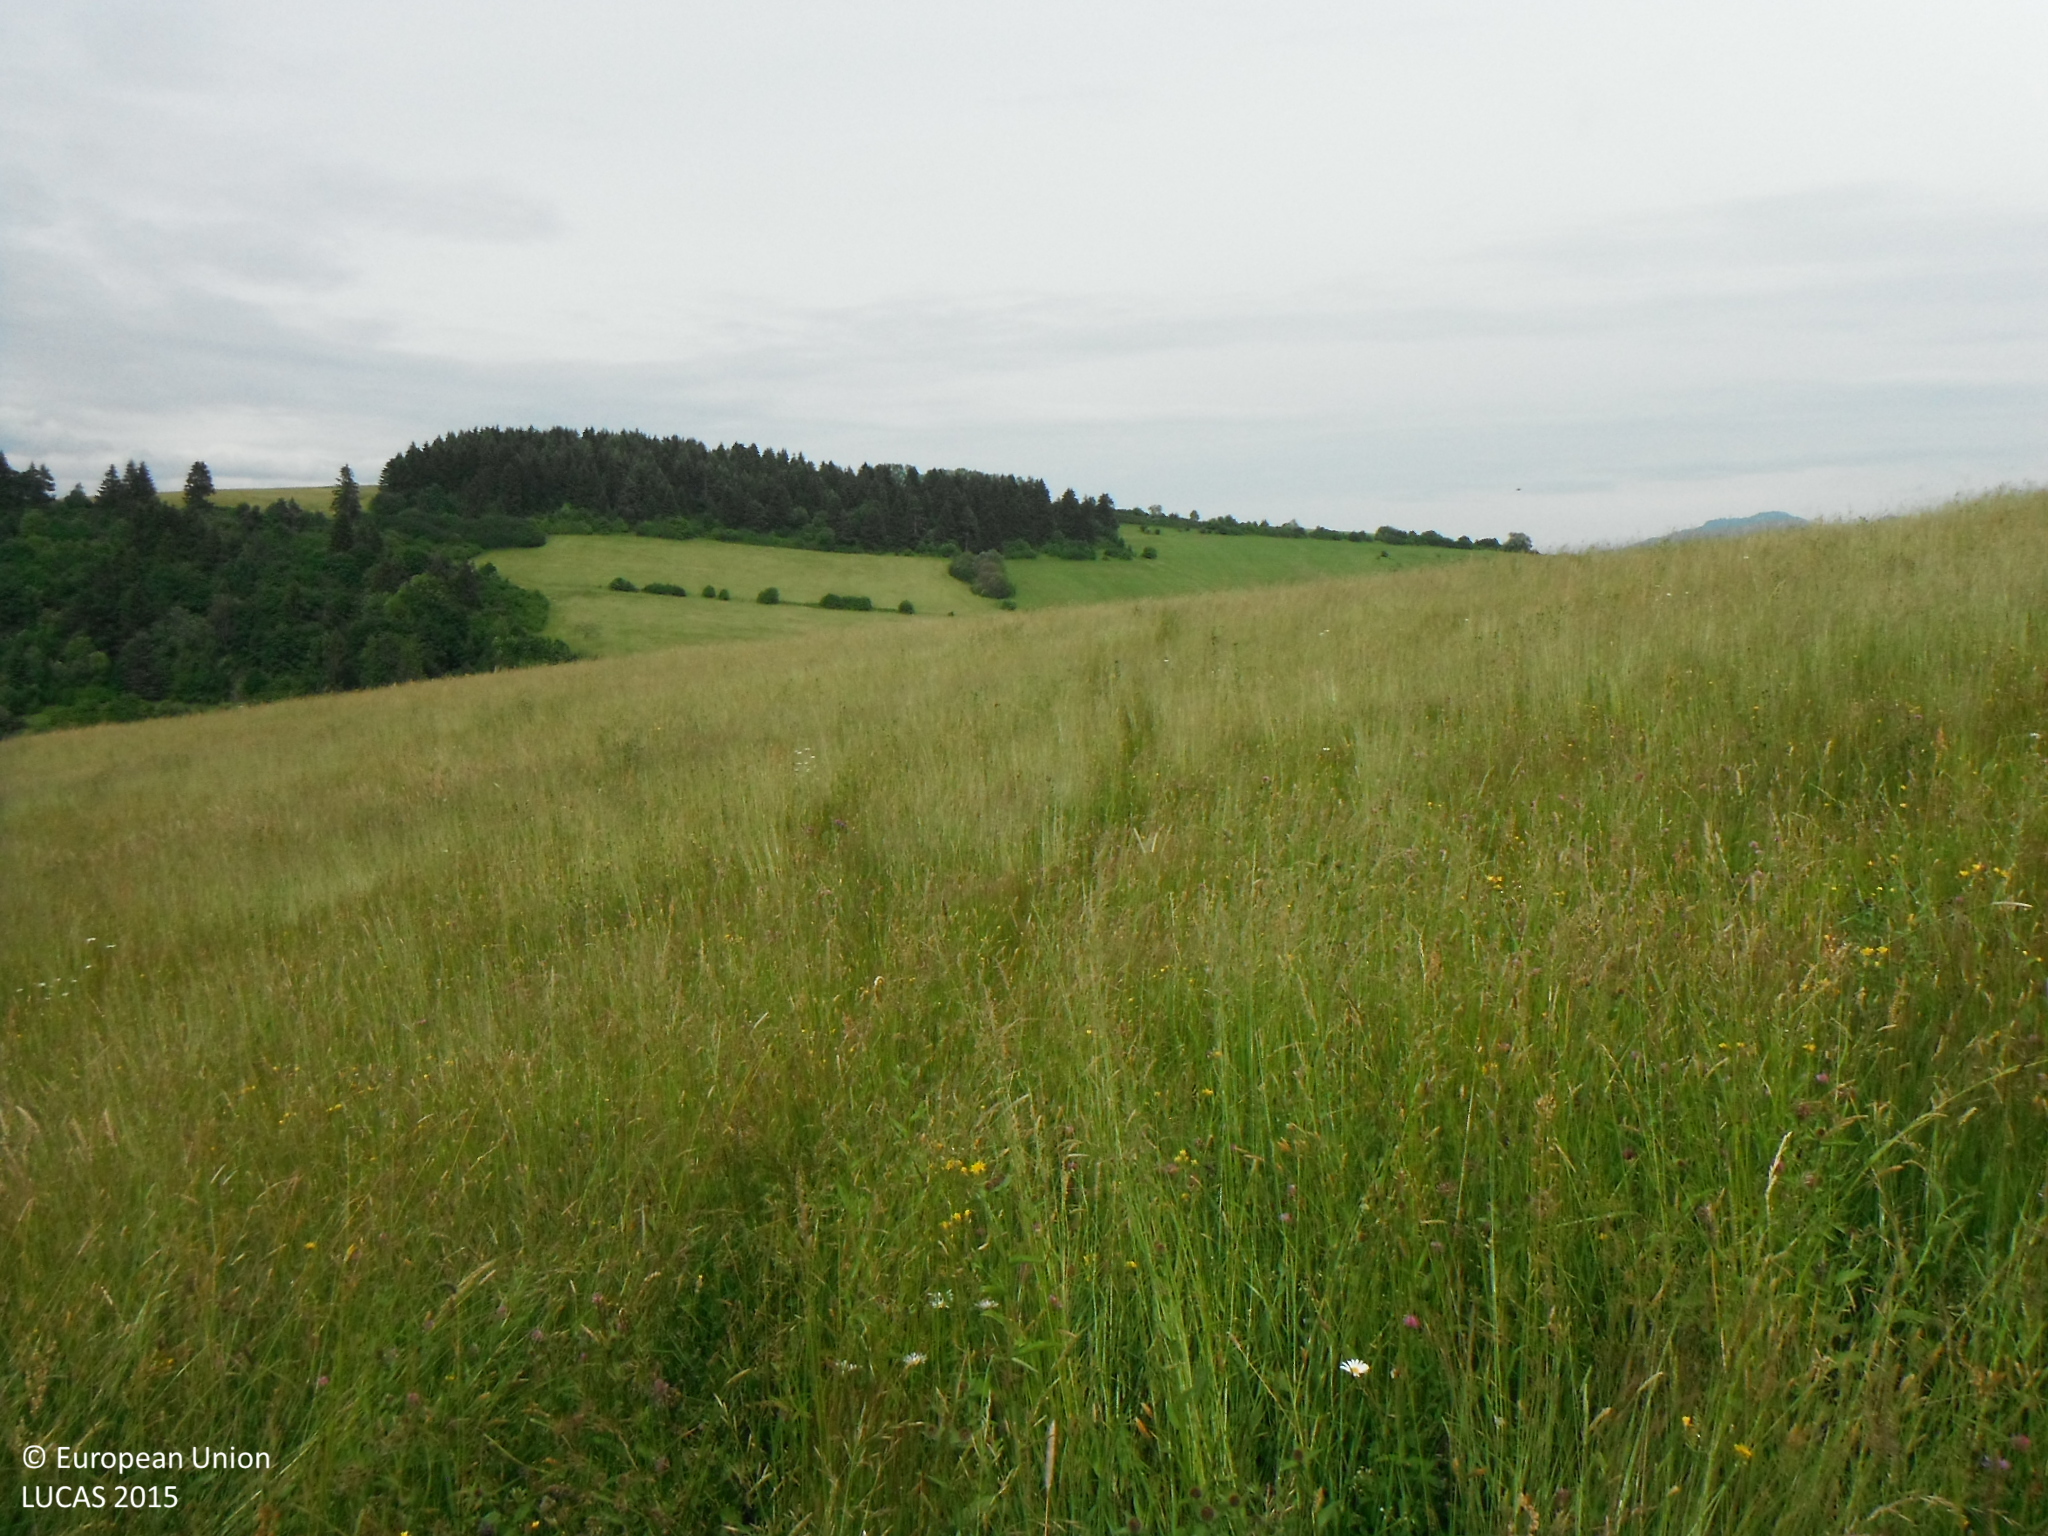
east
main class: Grassland
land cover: Grassland without tree/shrub cover
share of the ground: > 75 %
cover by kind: herbaceous plants 100 %
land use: Agriculture (excluding fallow land and kitchen gardens)
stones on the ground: < 10 %
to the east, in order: Grassland without tree/shrub cover; Electric lines; Grassland without tree/shrub cover; Grassland with sparse tree/shrub cover; Grassland without tree/shrub cover; Electric lines; Shrubland without tree cover; Grass margins; Paved roads, cycling and walking lanes
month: June
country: SK
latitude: 49.0661
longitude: 19.4560
